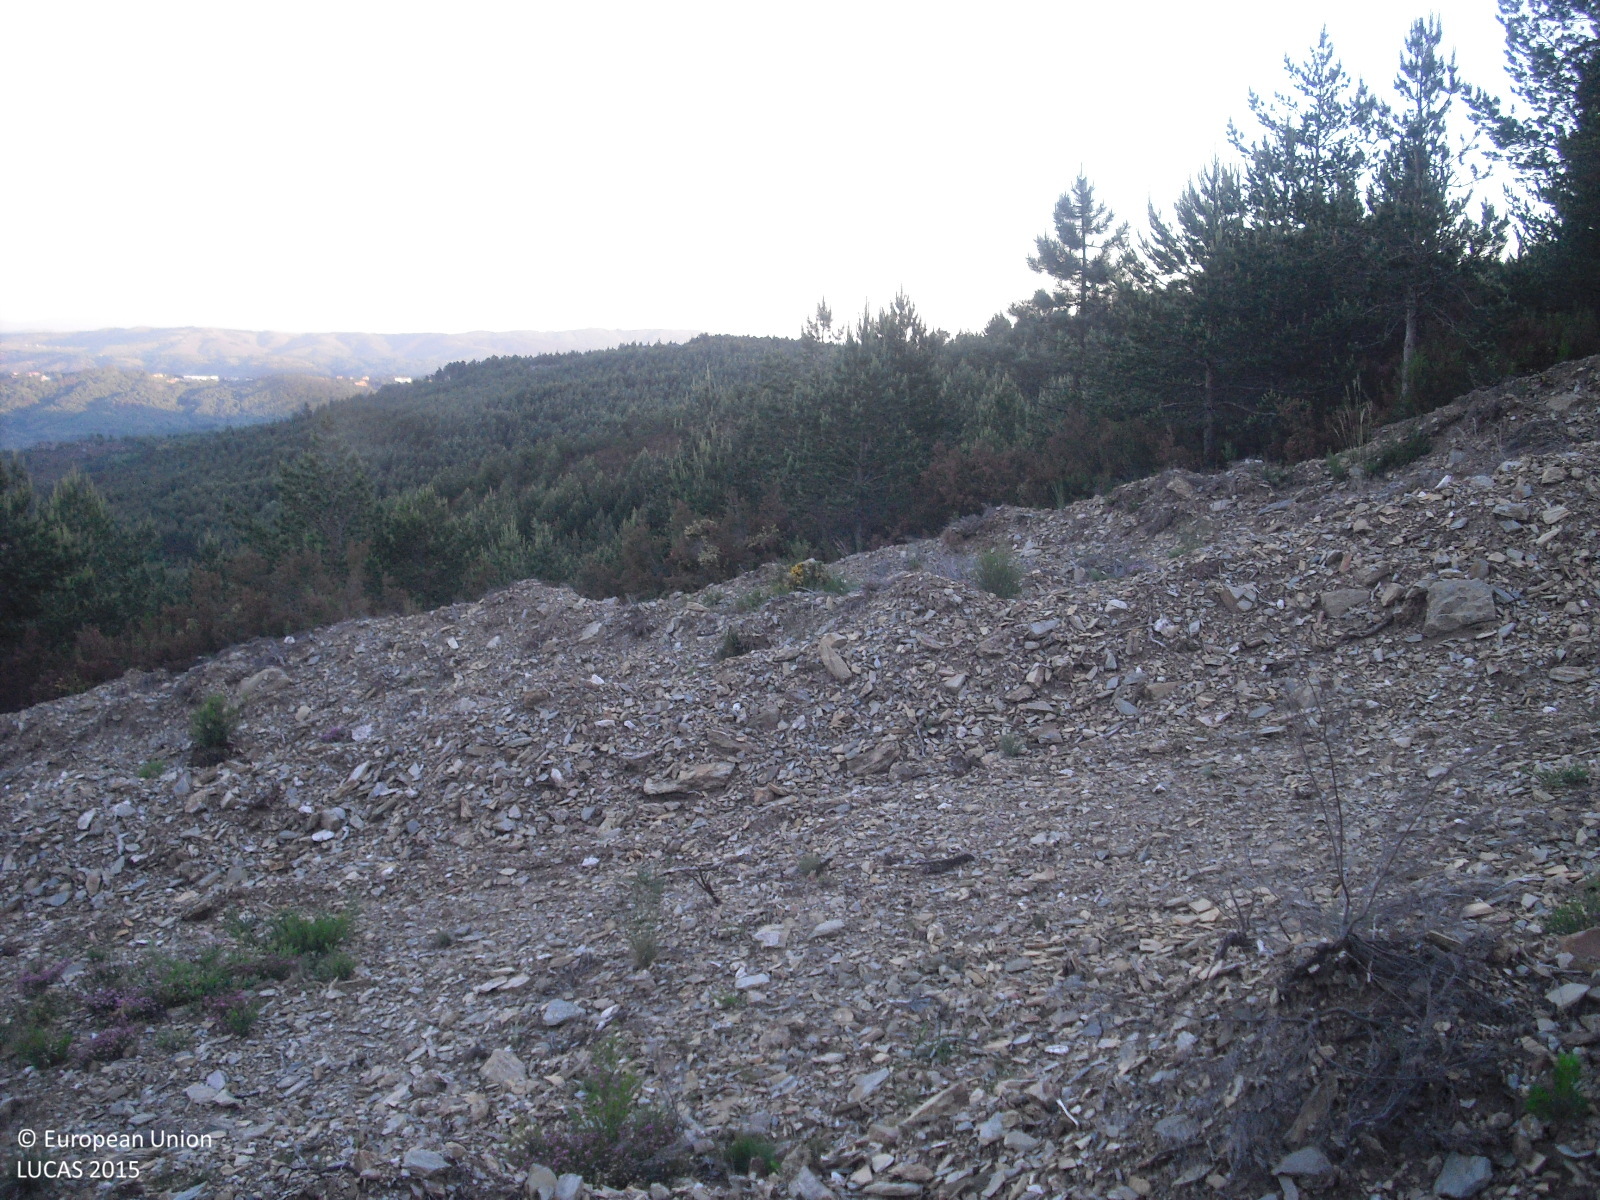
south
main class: Woodland
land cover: Pine dominated coniferous woodland
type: hemiboreal forest and nemoral coniferous forest and mixed broadleaved-coniferous forest
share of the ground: > 75 %
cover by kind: coniferous forest trees 80 %, shrubs 20 %
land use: Forestry
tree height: < 5 m
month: May
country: ES
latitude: 42.0332
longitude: -7.3191
